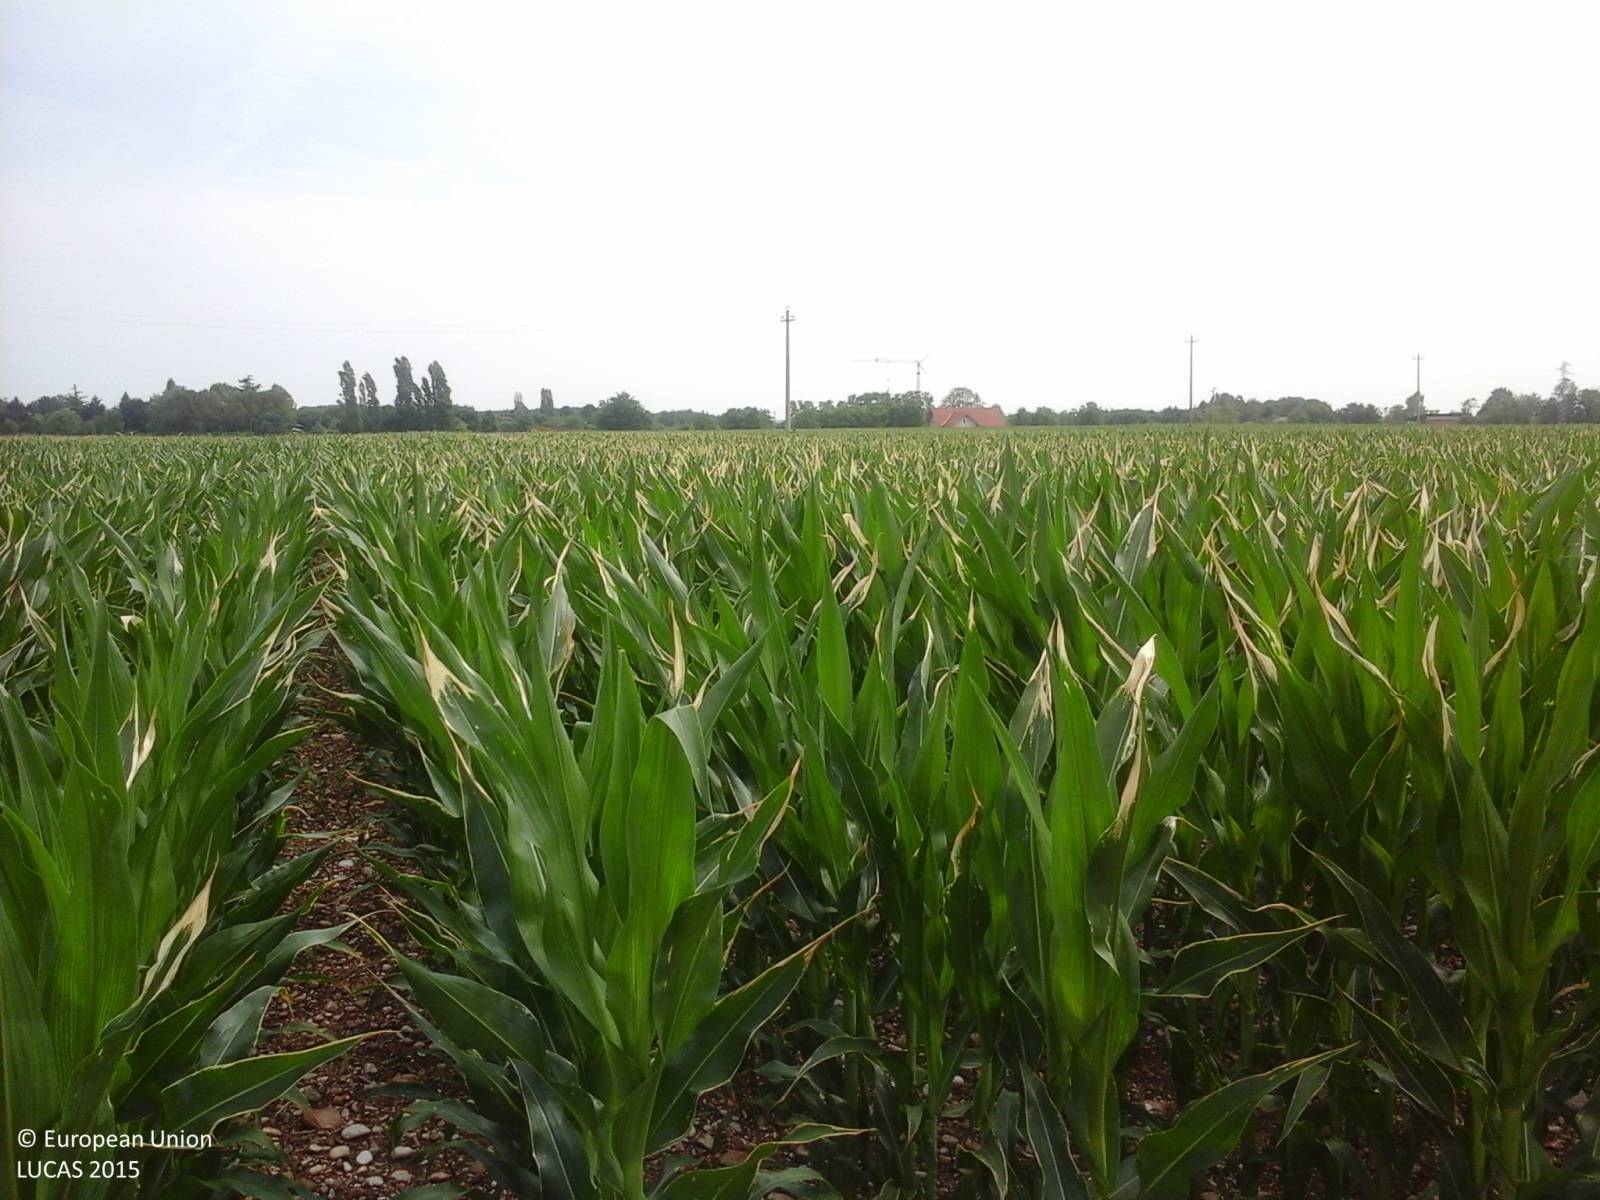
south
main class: Cropland
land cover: Maize
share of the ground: > 75 %
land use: Agriculture (excluding fallow land and kitchen gardens)
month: June
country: IT
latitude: 46.0108
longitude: 12.6959
